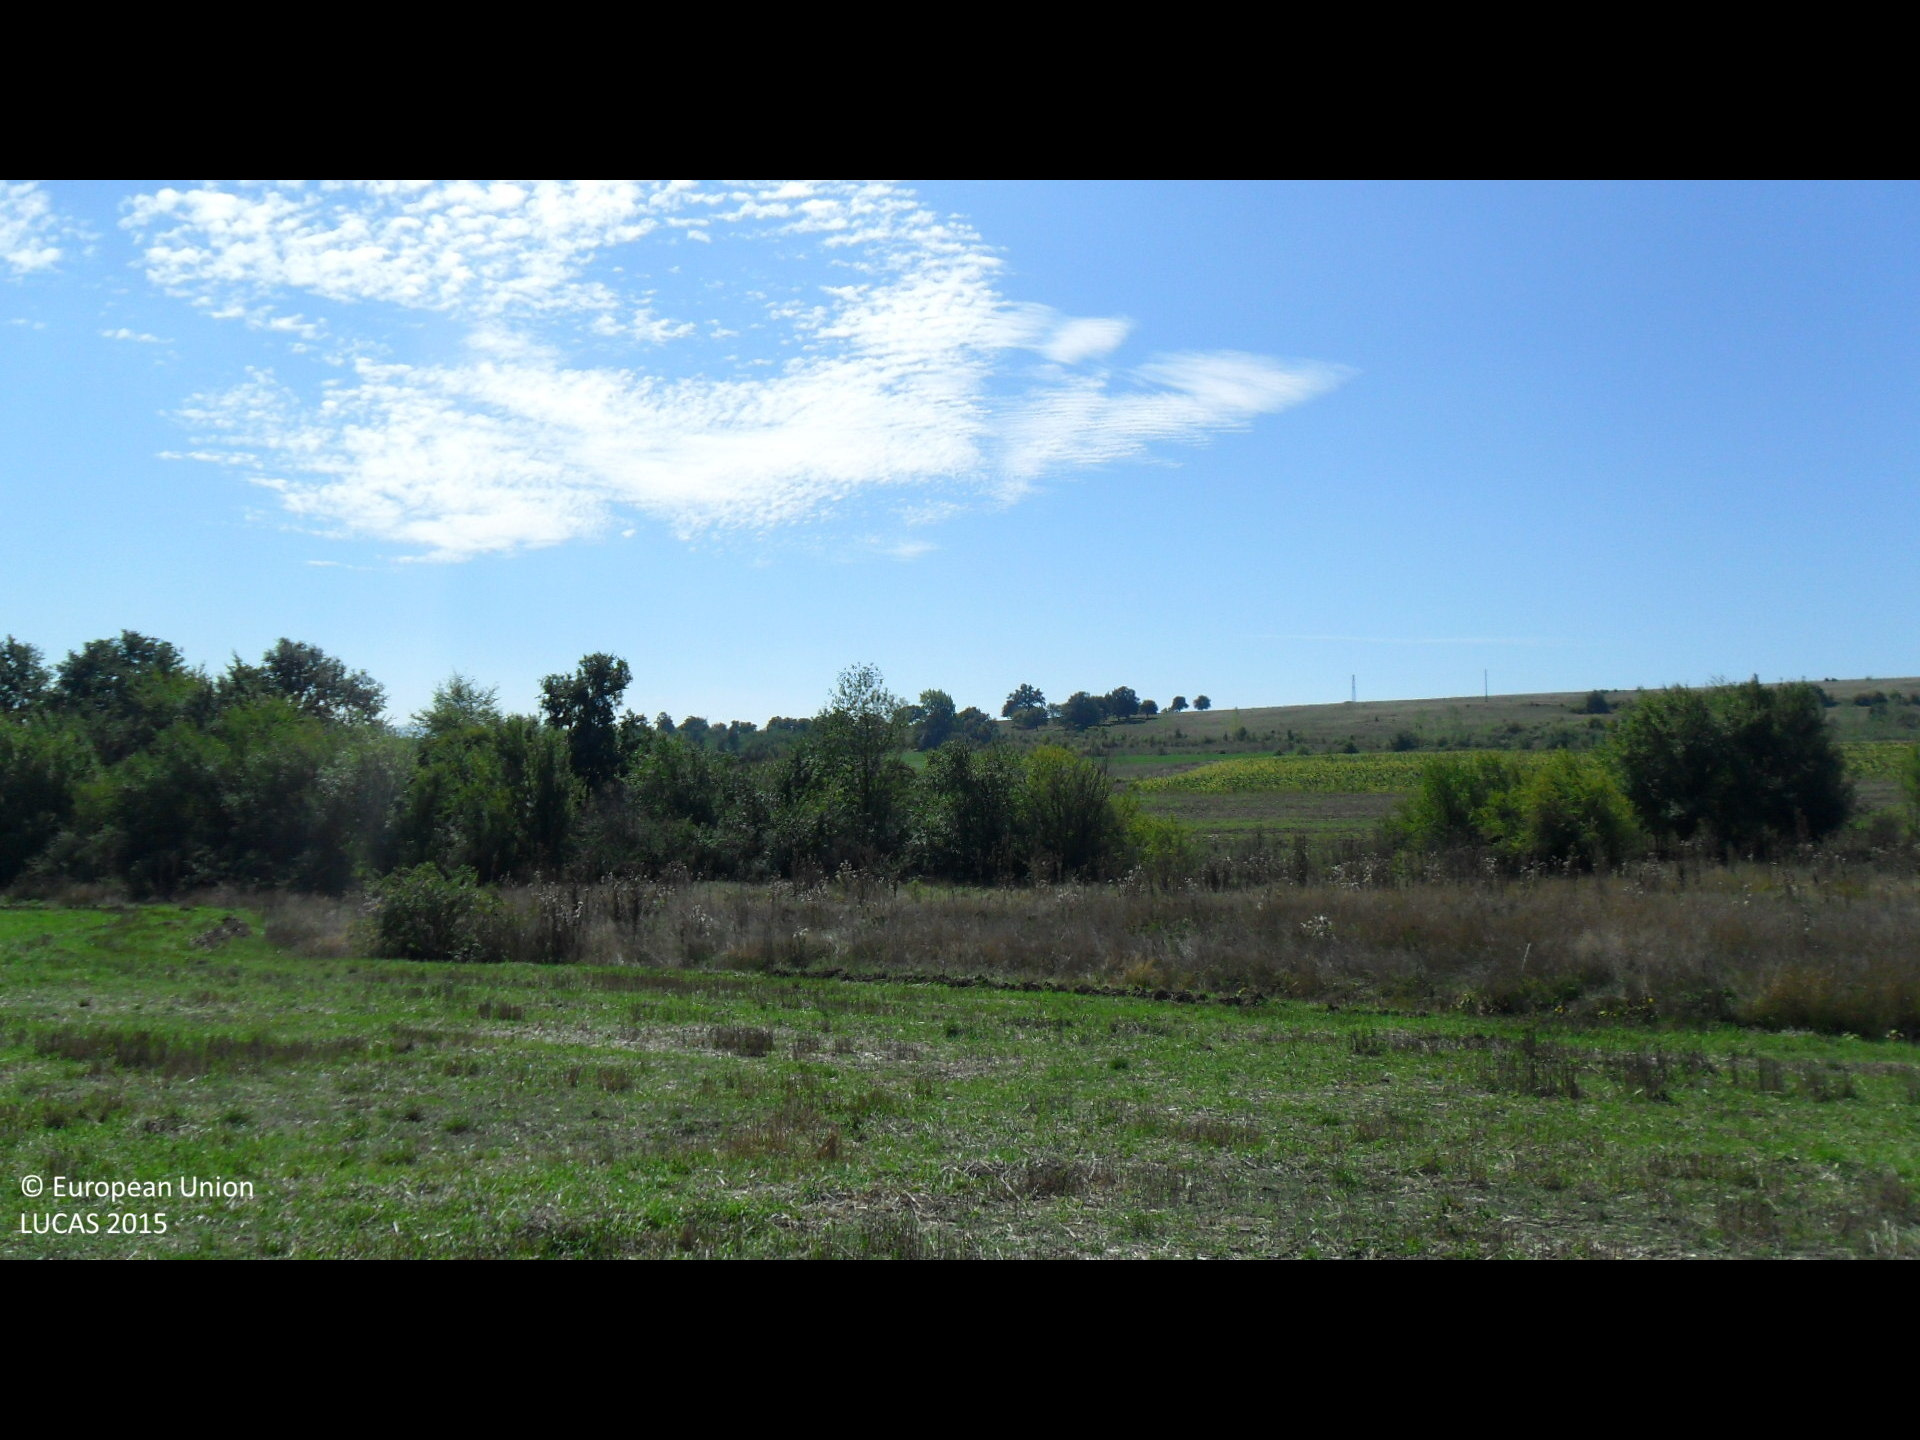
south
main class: Cropland
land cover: Barley
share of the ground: < 10 %
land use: Agriculture (excluding fallow land and kitchen gardens)
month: September
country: BG
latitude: 43.0842
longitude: 26.5484
